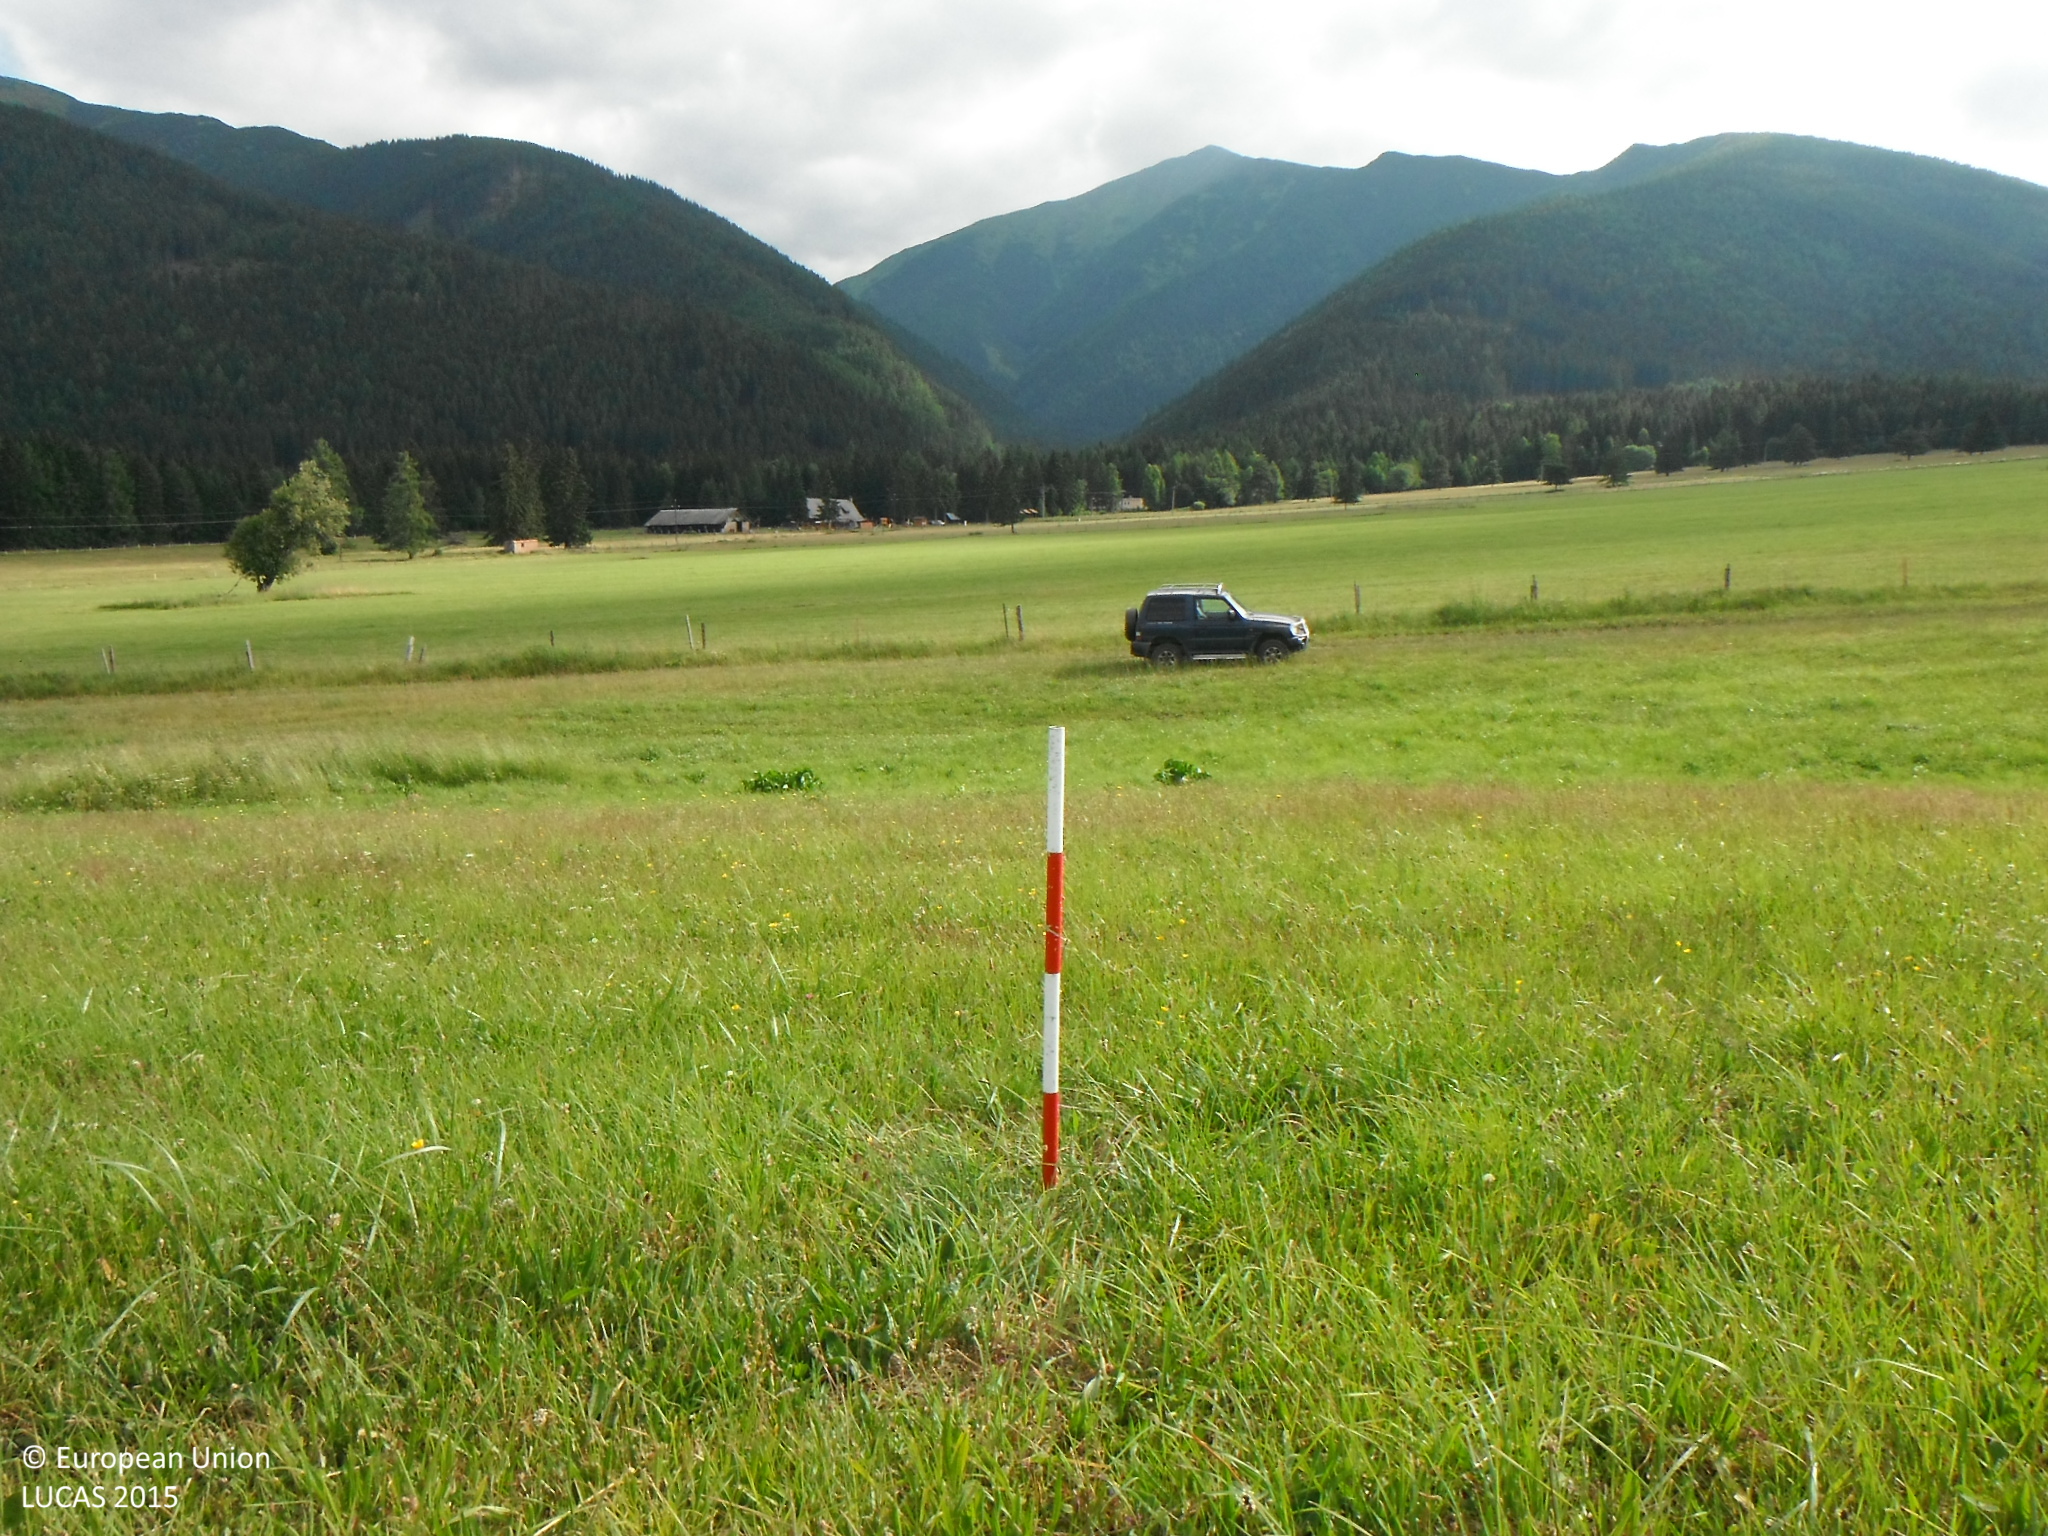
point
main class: Grassland
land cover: Grassland without tree/shrub cover
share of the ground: > 75 %
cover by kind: herbaceous plants 100 %
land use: Agriculture (excluding fallow land and kitchen gardens)
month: July
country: SK
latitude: 49.1365
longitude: 19.6910
